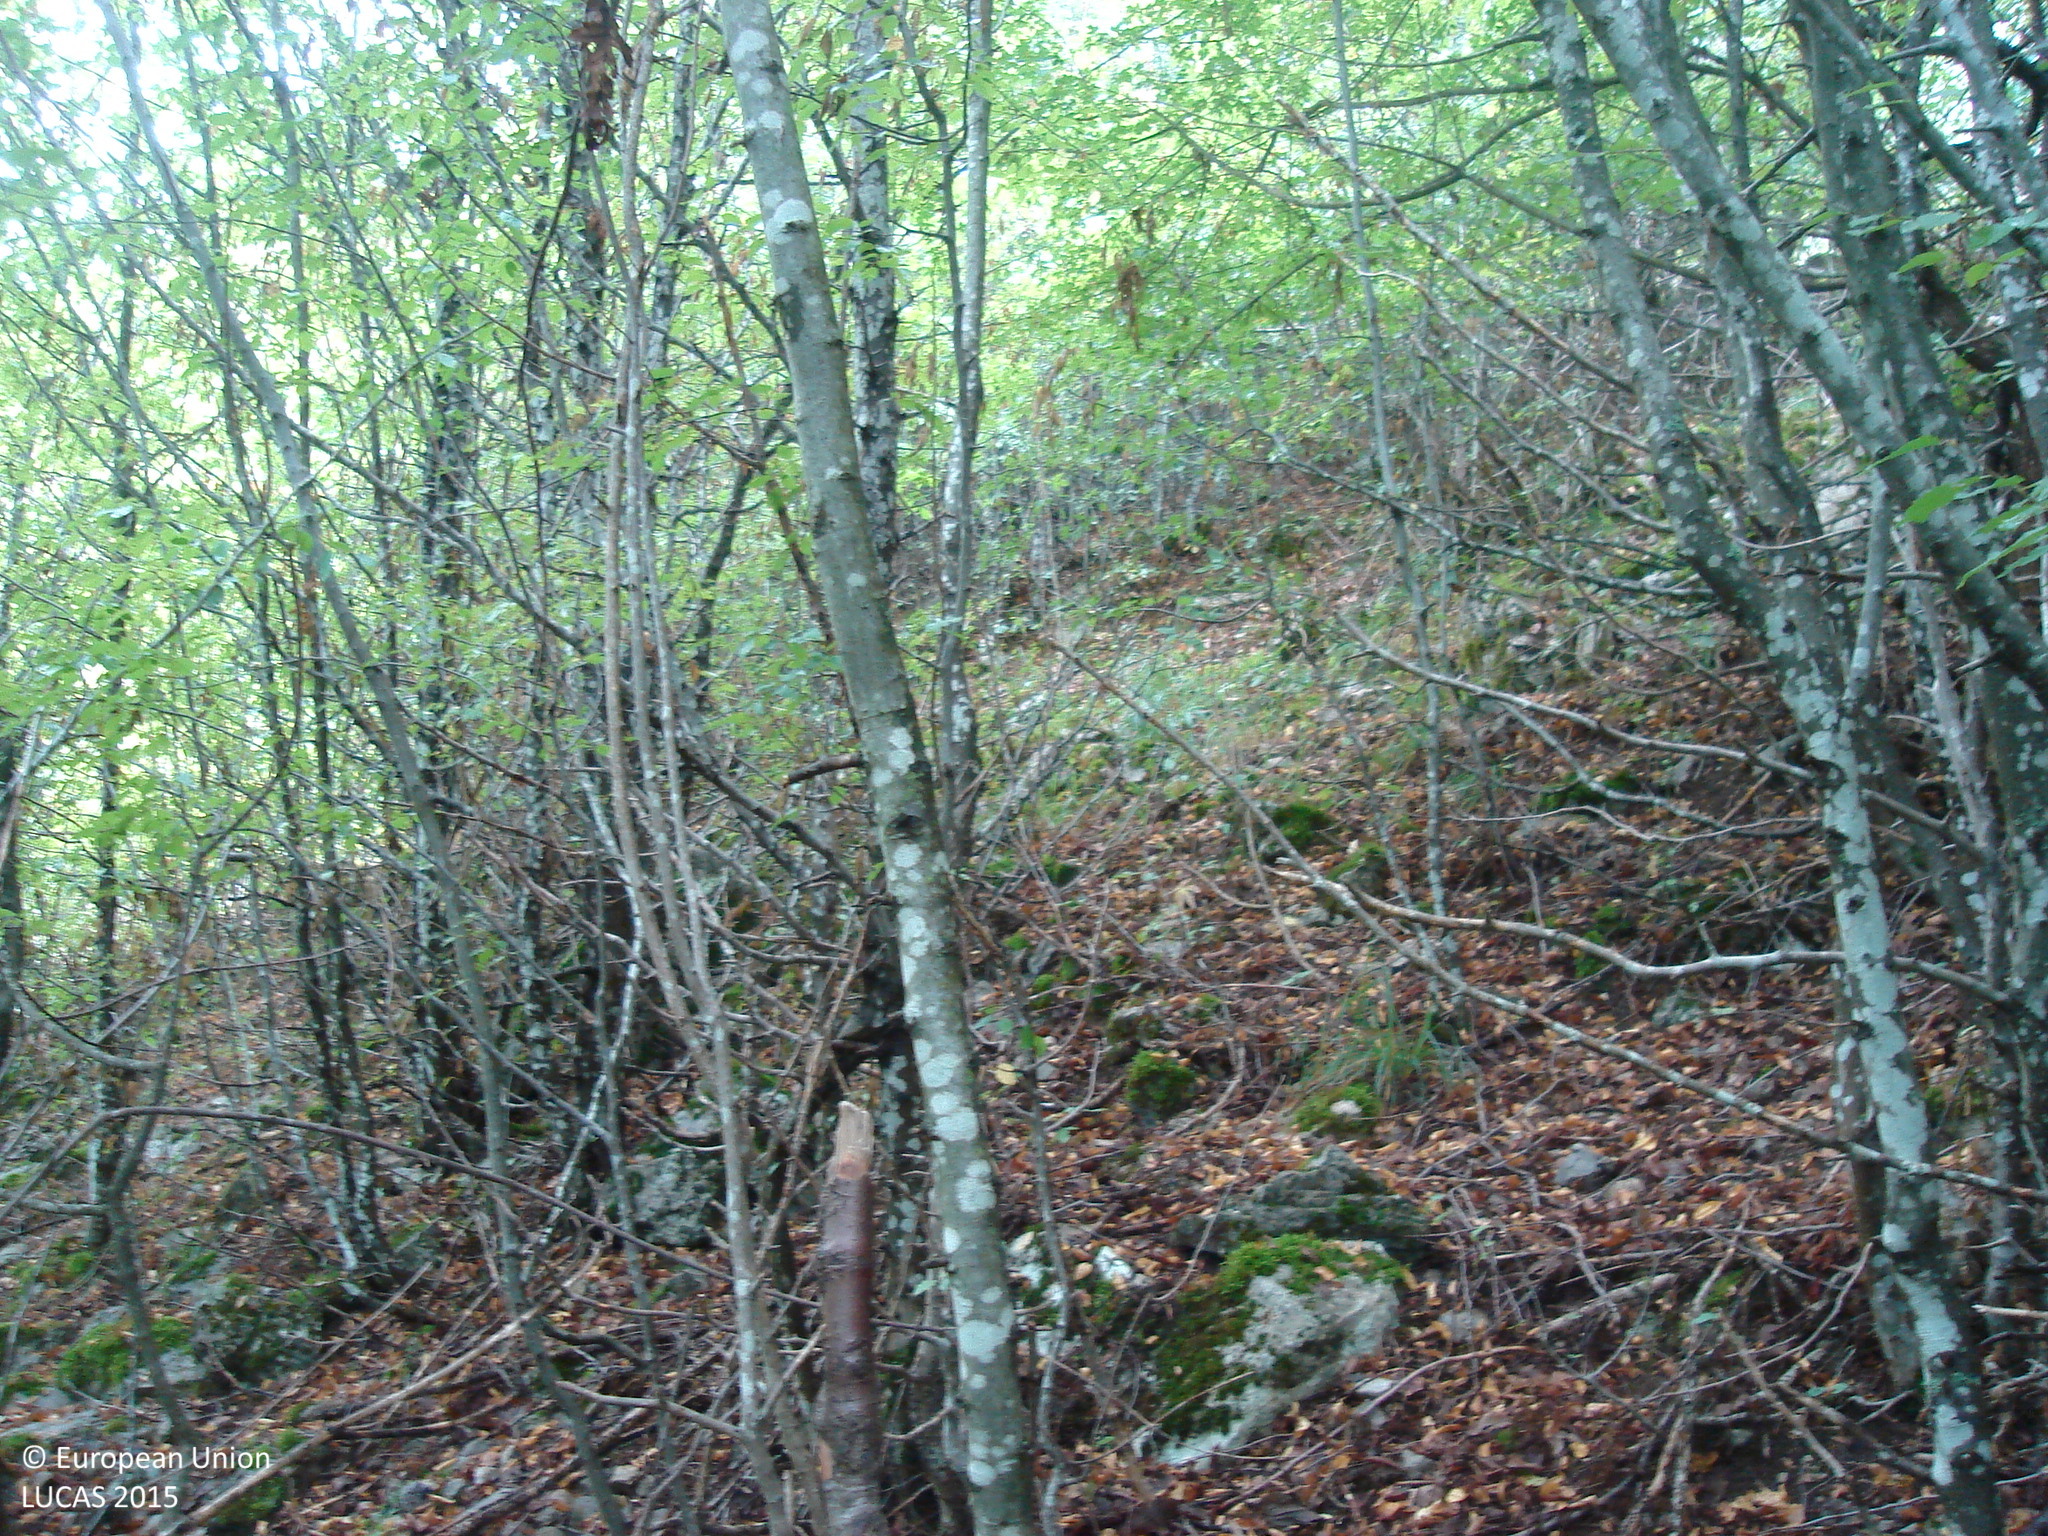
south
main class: Woodland
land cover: Broadleaved woodland
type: mesophytic deciduous forest
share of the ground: > 75 %
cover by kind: broadleaved forest trees 80 %, consolidated bare surface 20 %
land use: Forestry
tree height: > 5 m
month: September
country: BG
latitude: 43.0278
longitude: 23.2039
